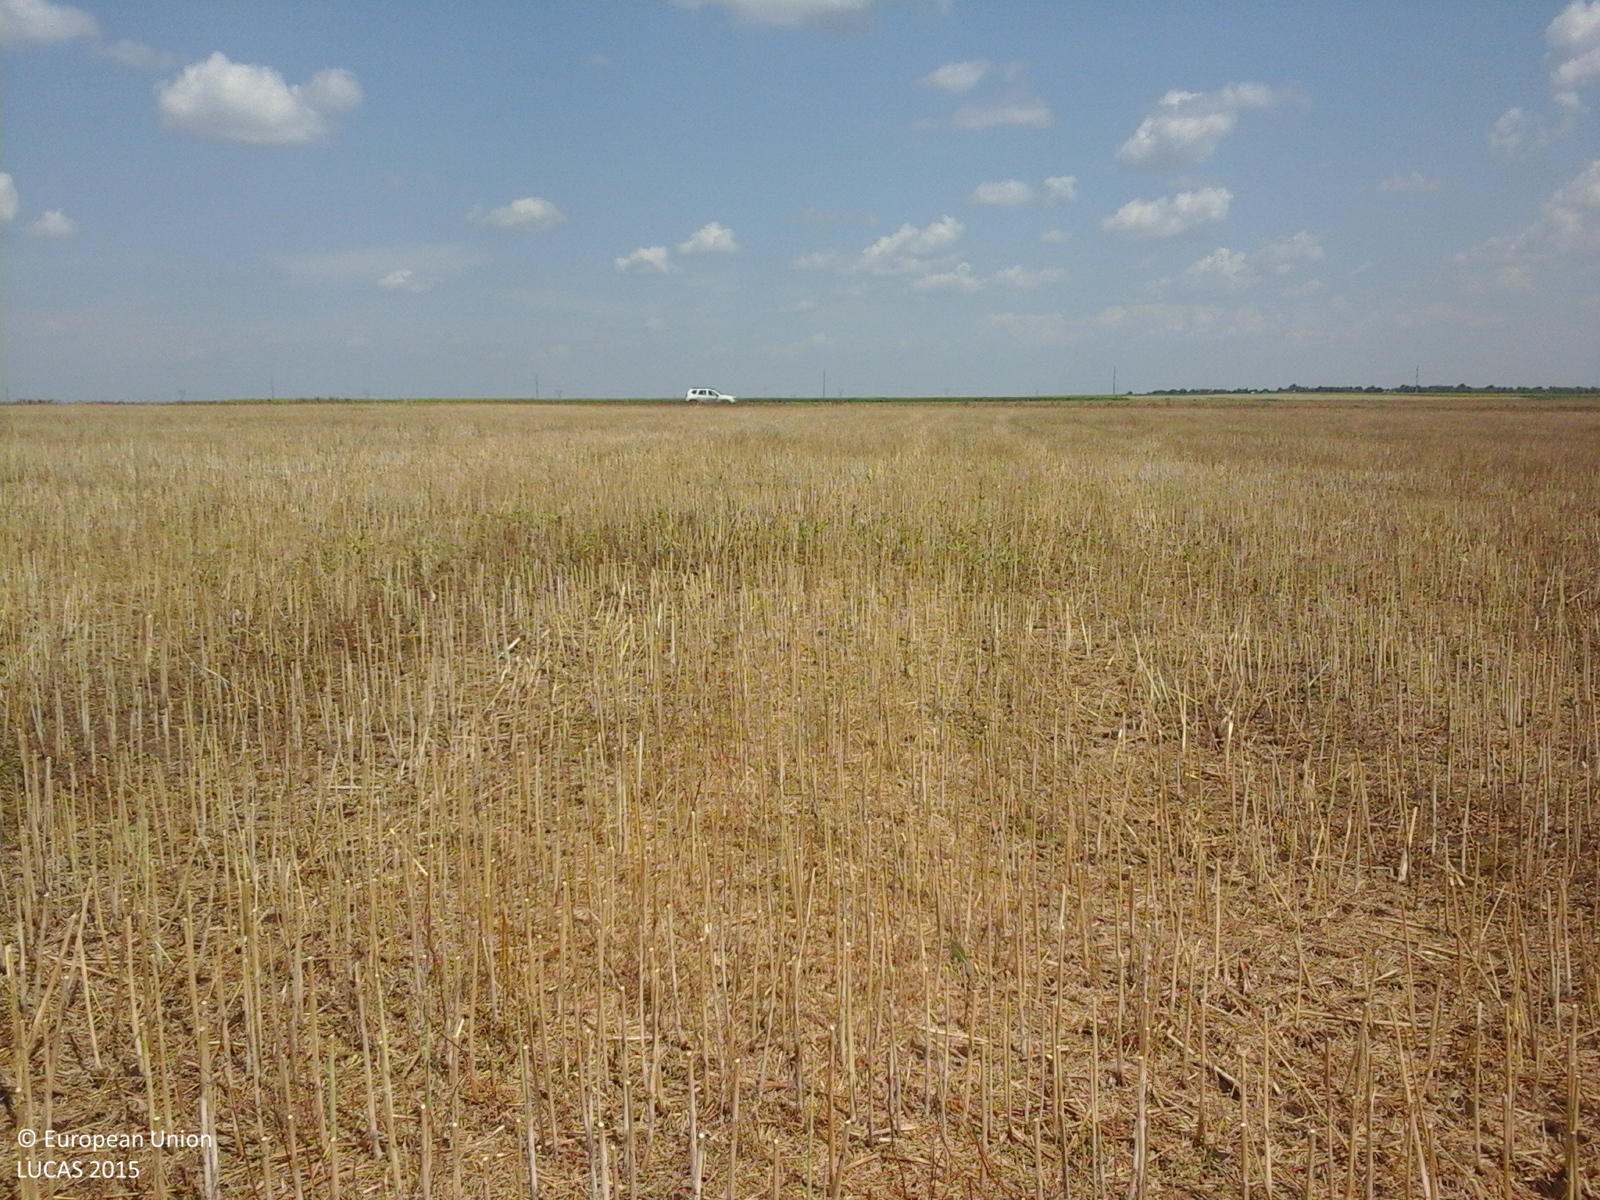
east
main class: Cropland
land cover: Rape and turnip rape
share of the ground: < 10 %
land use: Agriculture (excluding fallow land and kitchen gardens)
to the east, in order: Rape and turnip rape; Tracks; Common wheat
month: July
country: RO
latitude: 44.0380
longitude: 24.2507
